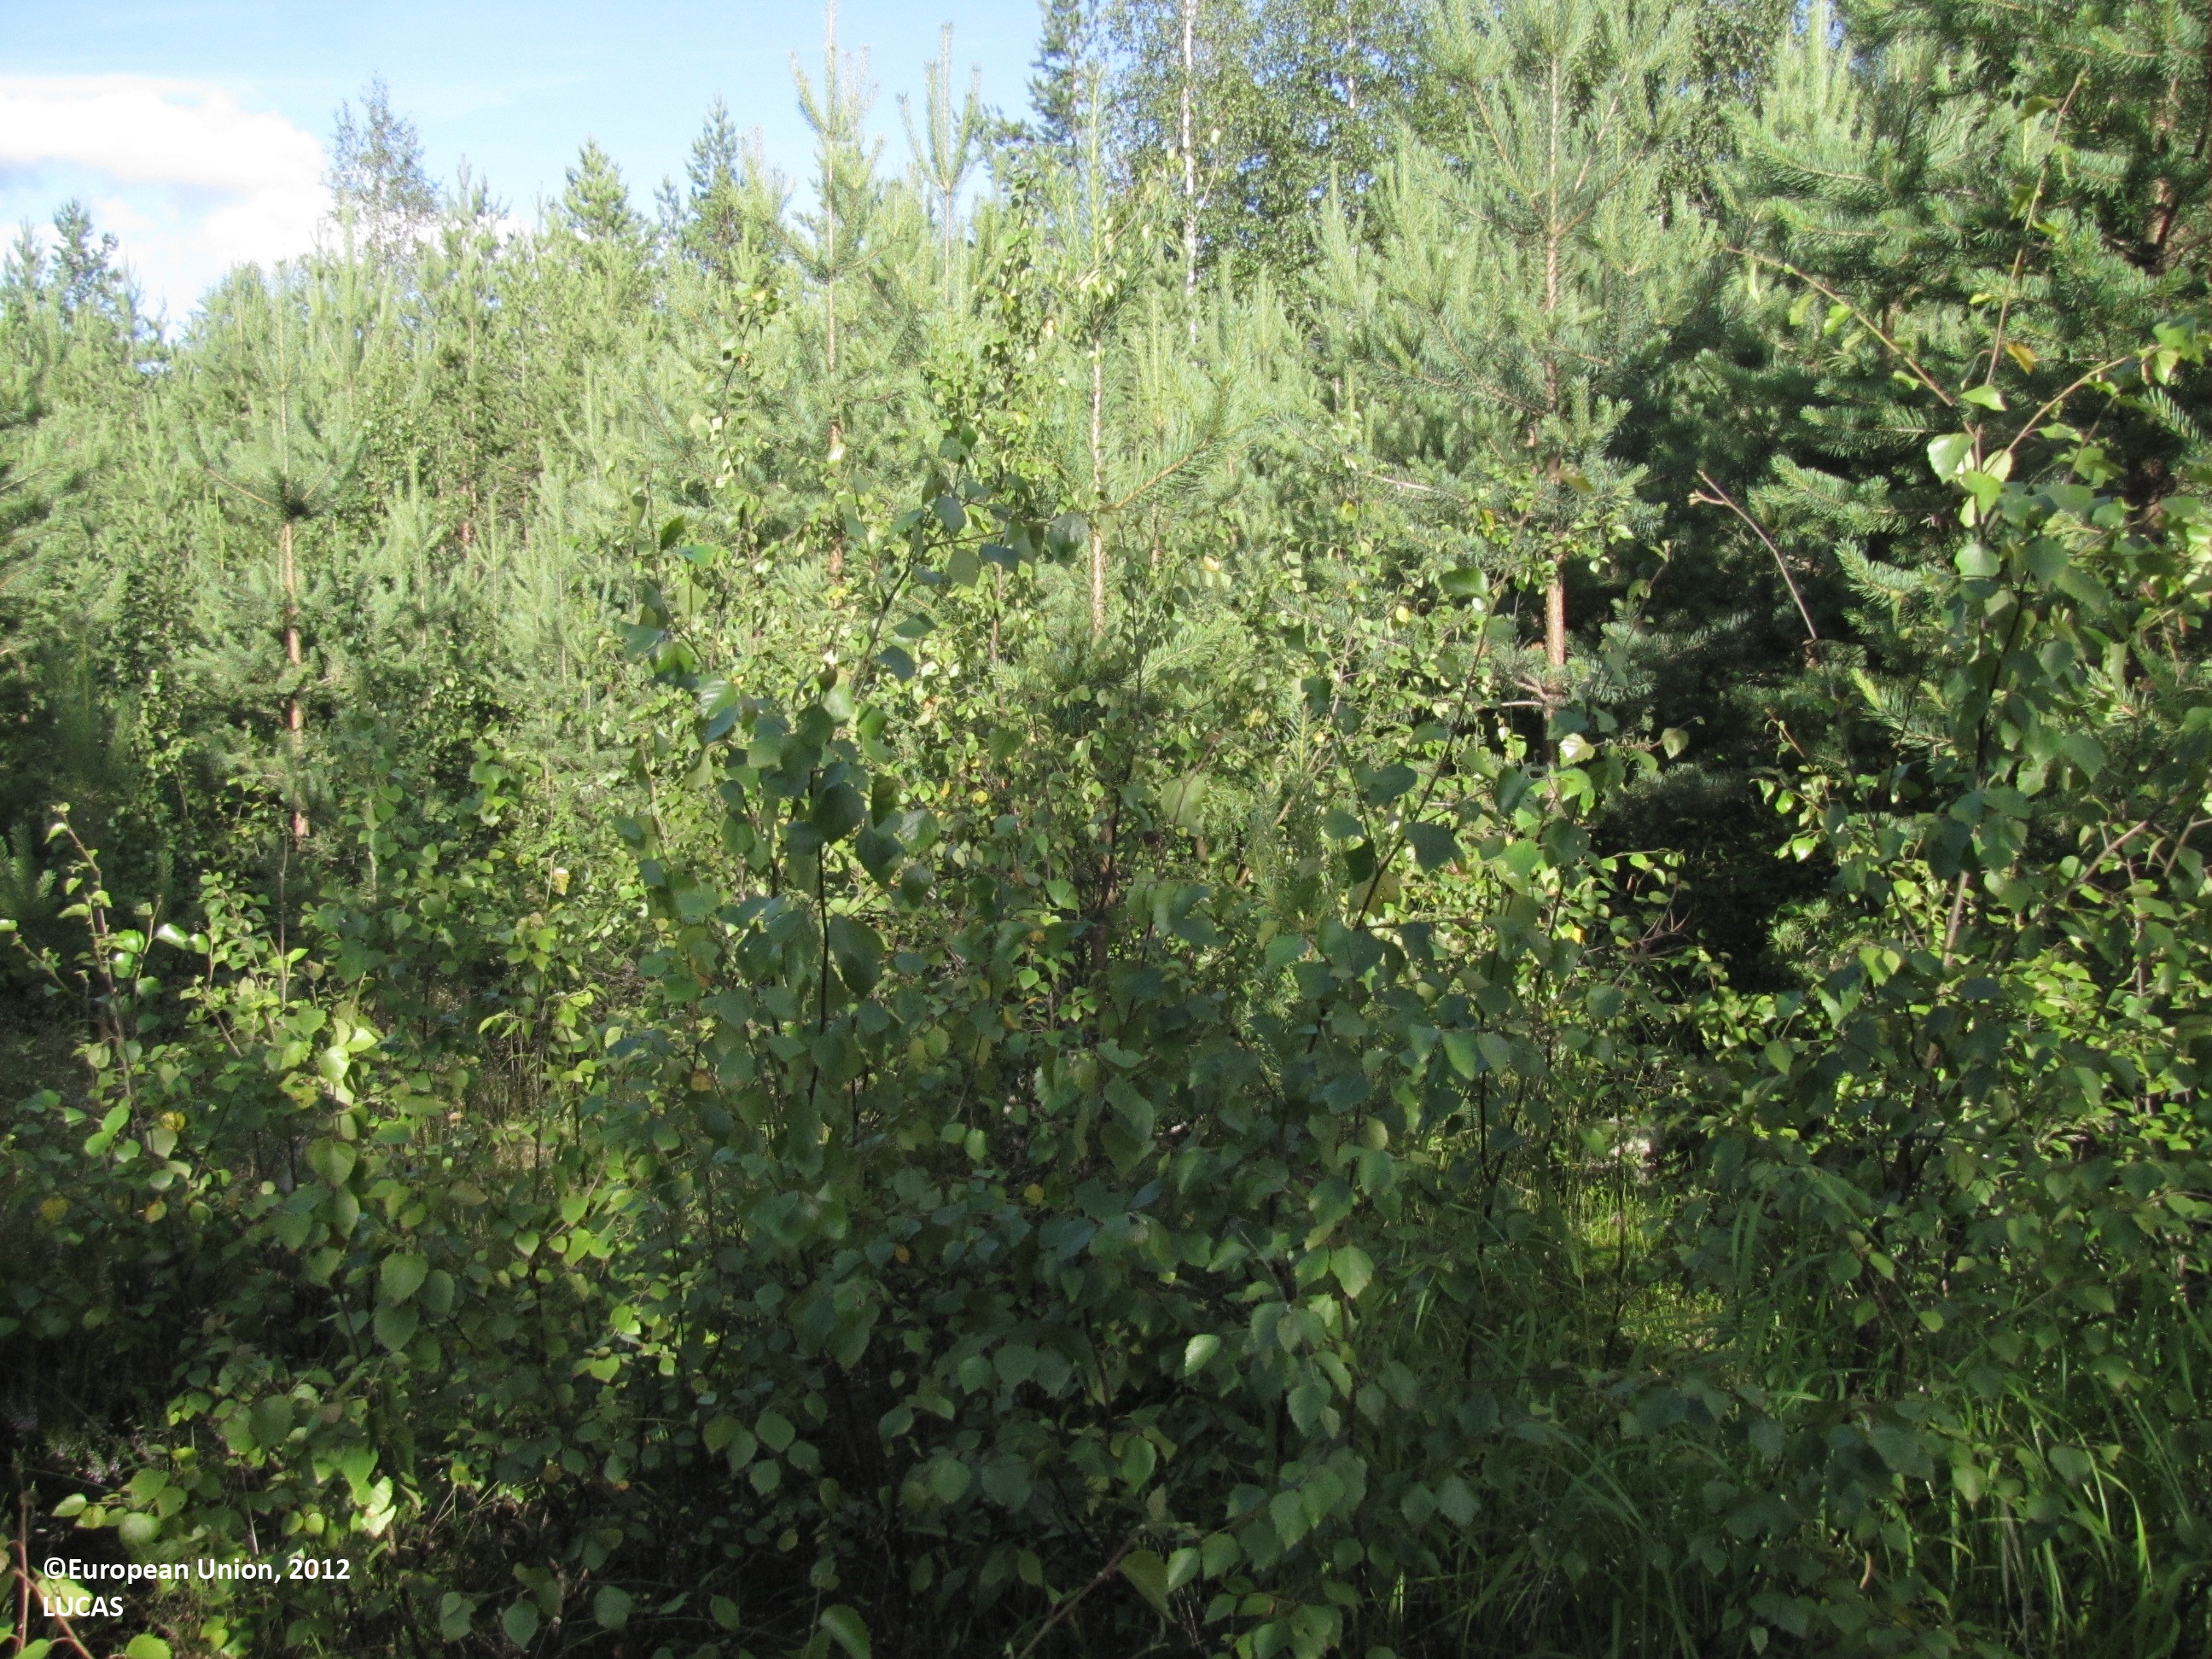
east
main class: Woodland
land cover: Pine dominated mixed woodland
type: boreal forest
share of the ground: > 75 %
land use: Forestry
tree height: < 5 m
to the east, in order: Pine dominated mixed woodland; Rivers and streams; Pine dominated mixed woodland; Pine dominated coniferous woodland; Ditches and canals; Pine dominated coniferous woodland; Ditches and canals; Pine dominated coniferous woodland; Pine dominated mixed woodland; Ditches and canals; Pine dominated coniferous woodland
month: July
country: FI
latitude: 62.3128
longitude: 23.0879
